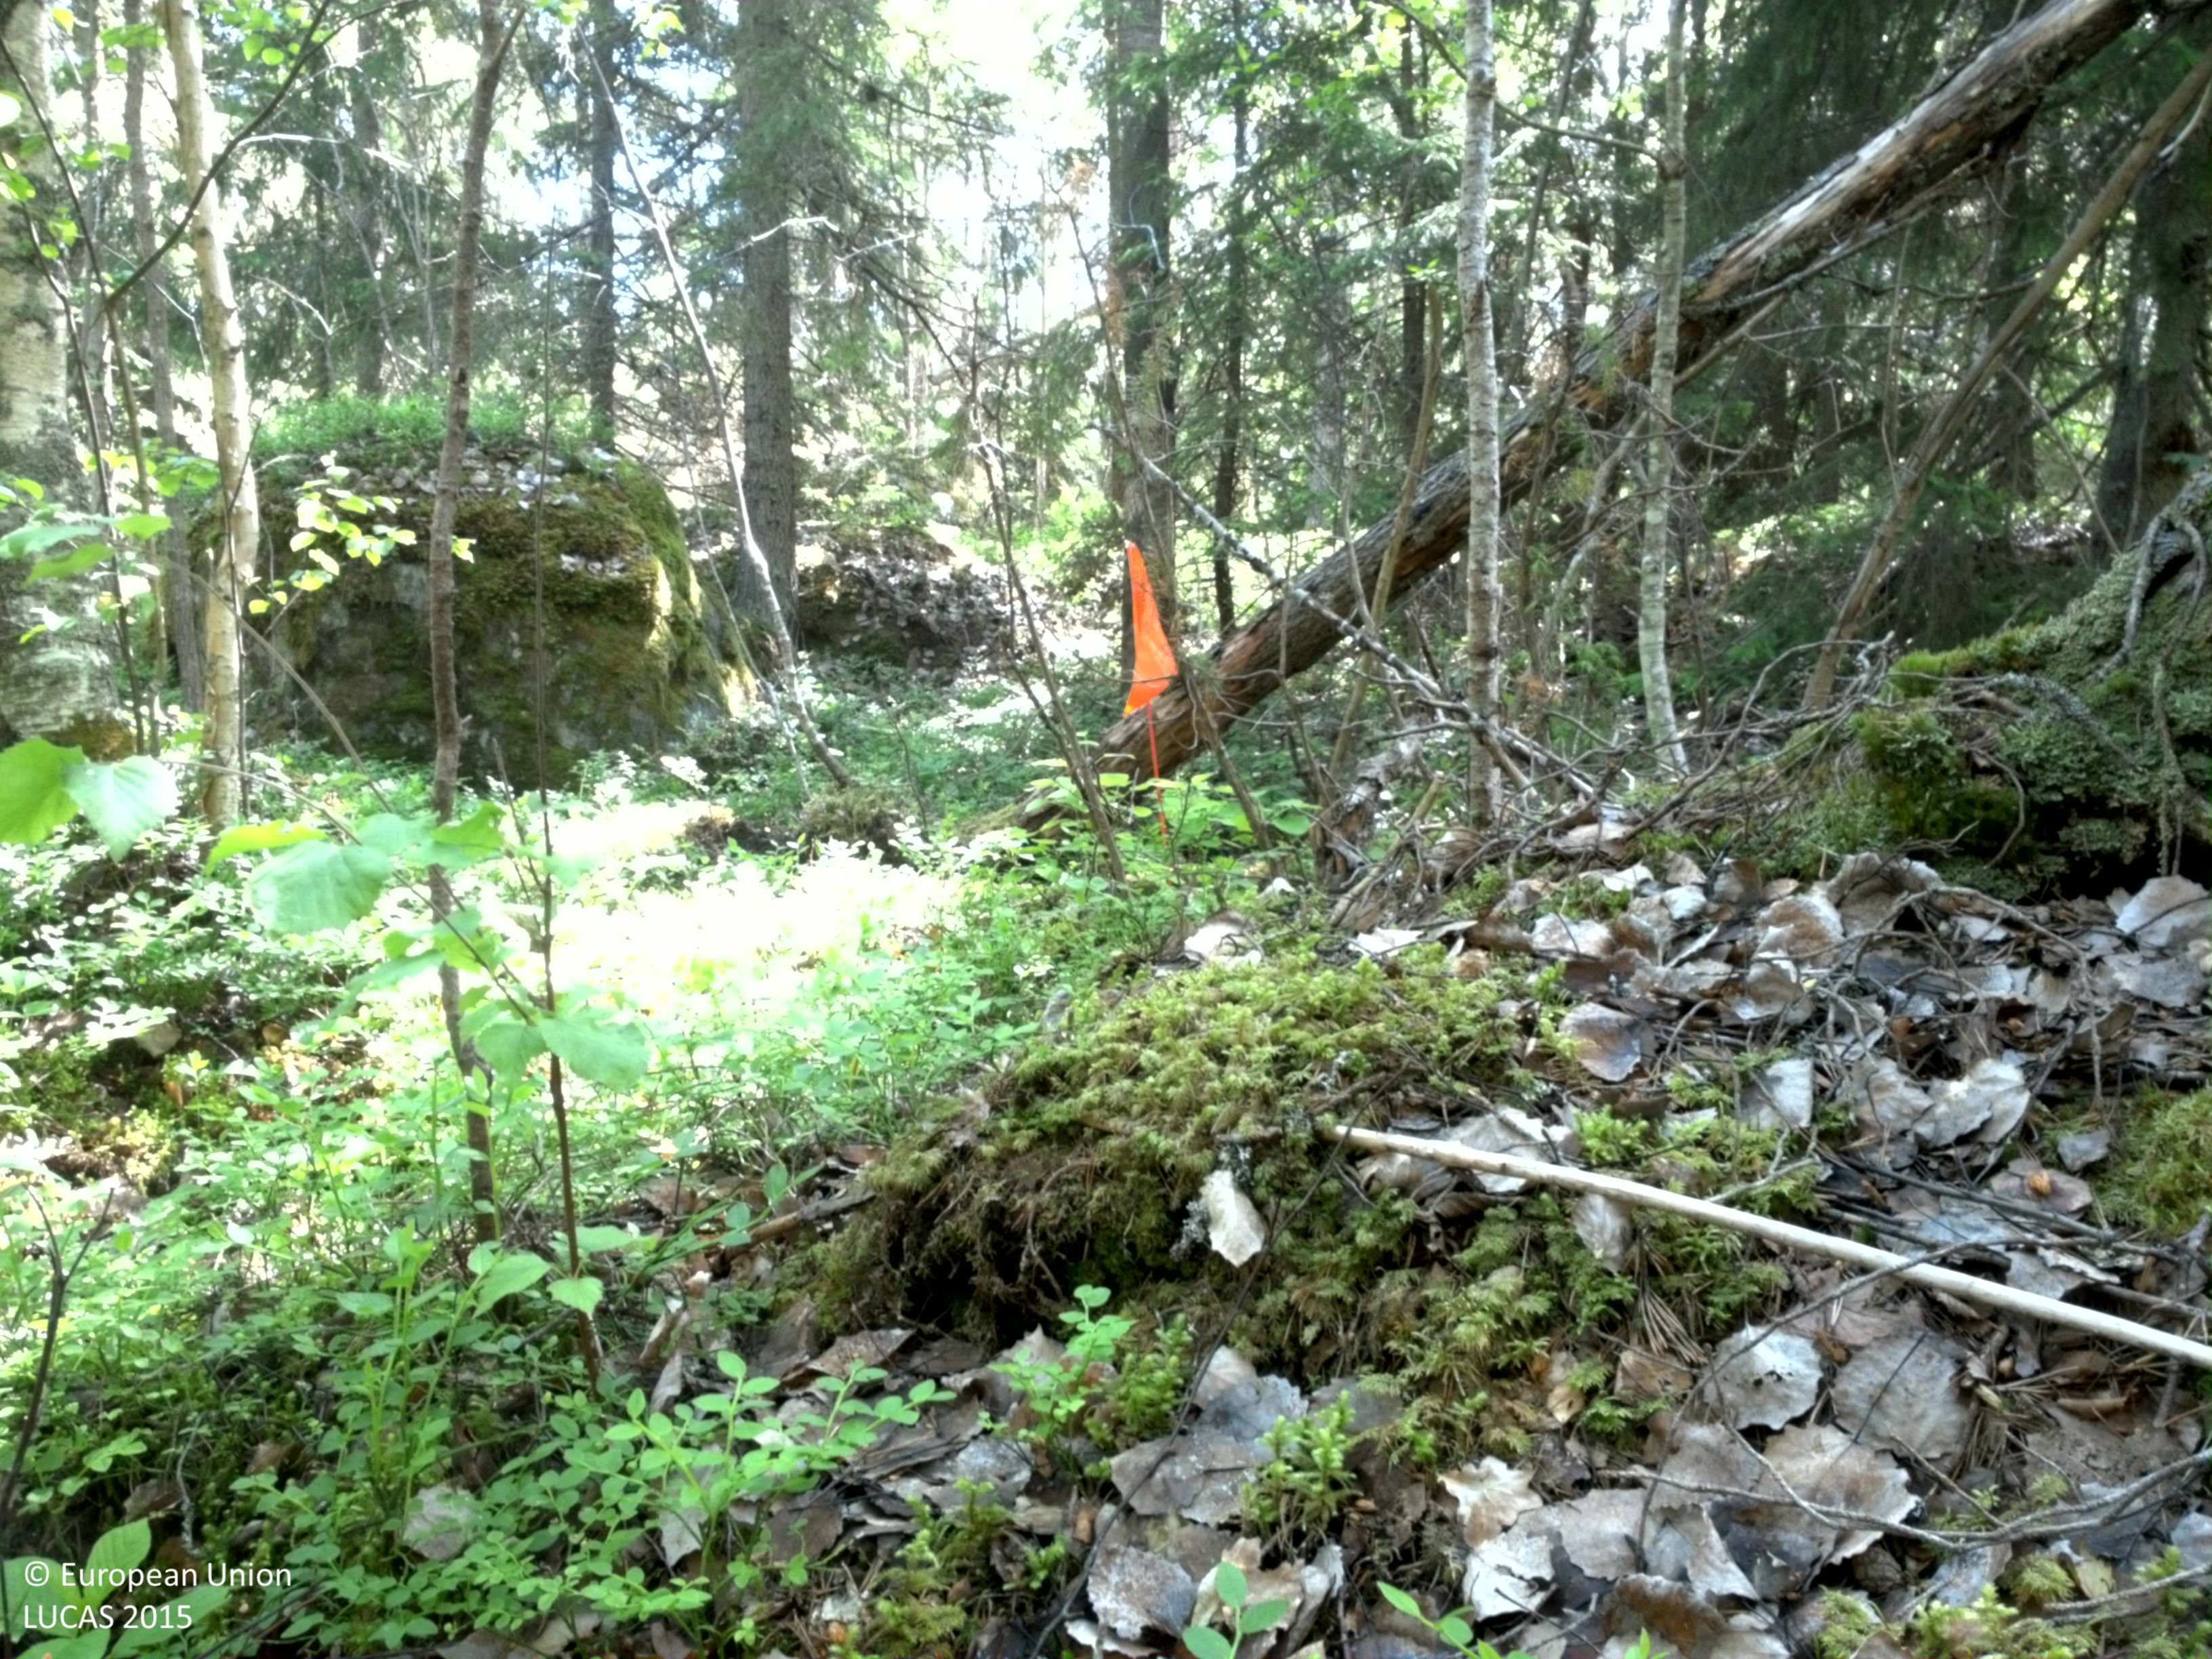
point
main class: Woodland
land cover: Spruce dominated mixed woodland
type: boreal forest
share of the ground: 50 - 75 %
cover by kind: coniferous forest trees 45 %, lichens and mosses 25 %, broadleaved forest trees 15 %, herbaceous plants 15 %
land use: Forestry
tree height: > 5 m
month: June
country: SE
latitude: 60.1140
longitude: 18.6521
